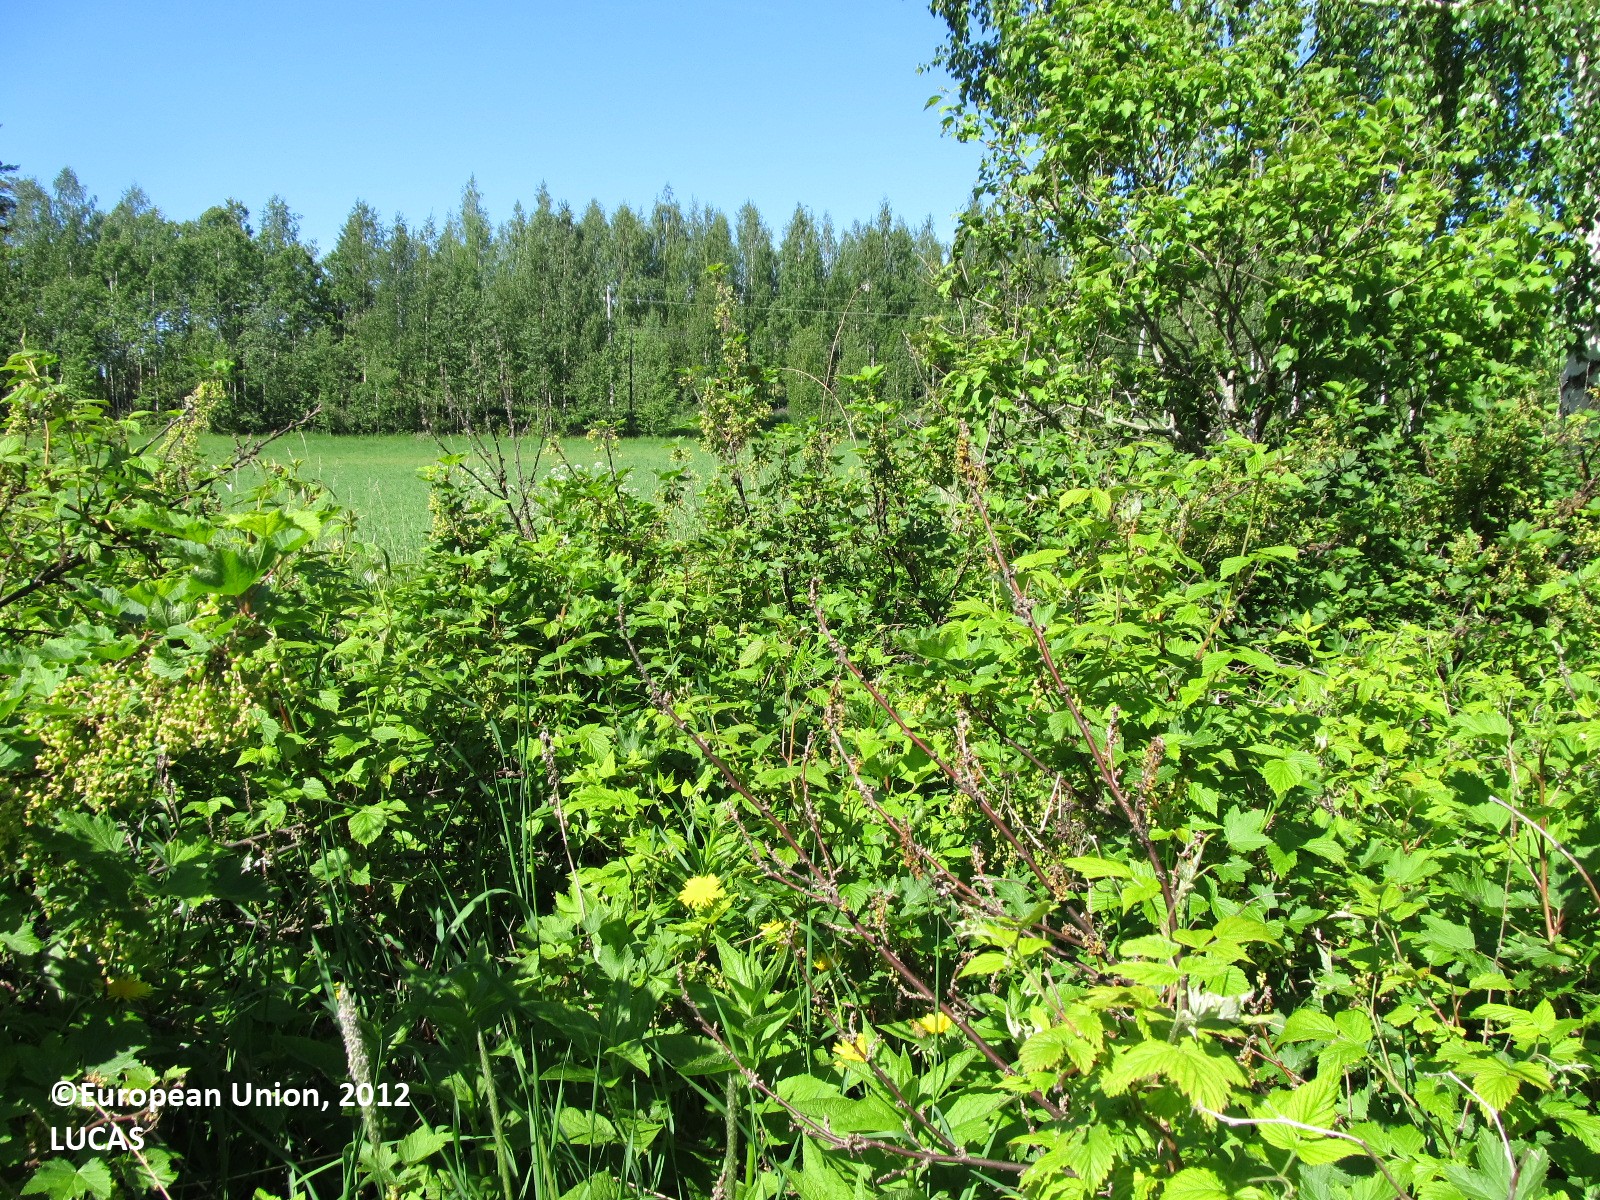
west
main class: Cropland
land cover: Other fruit trees and berries
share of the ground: 50 - 75 %
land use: Kitchen garden
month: June
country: FI
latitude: 62.9661
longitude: 27.8226
